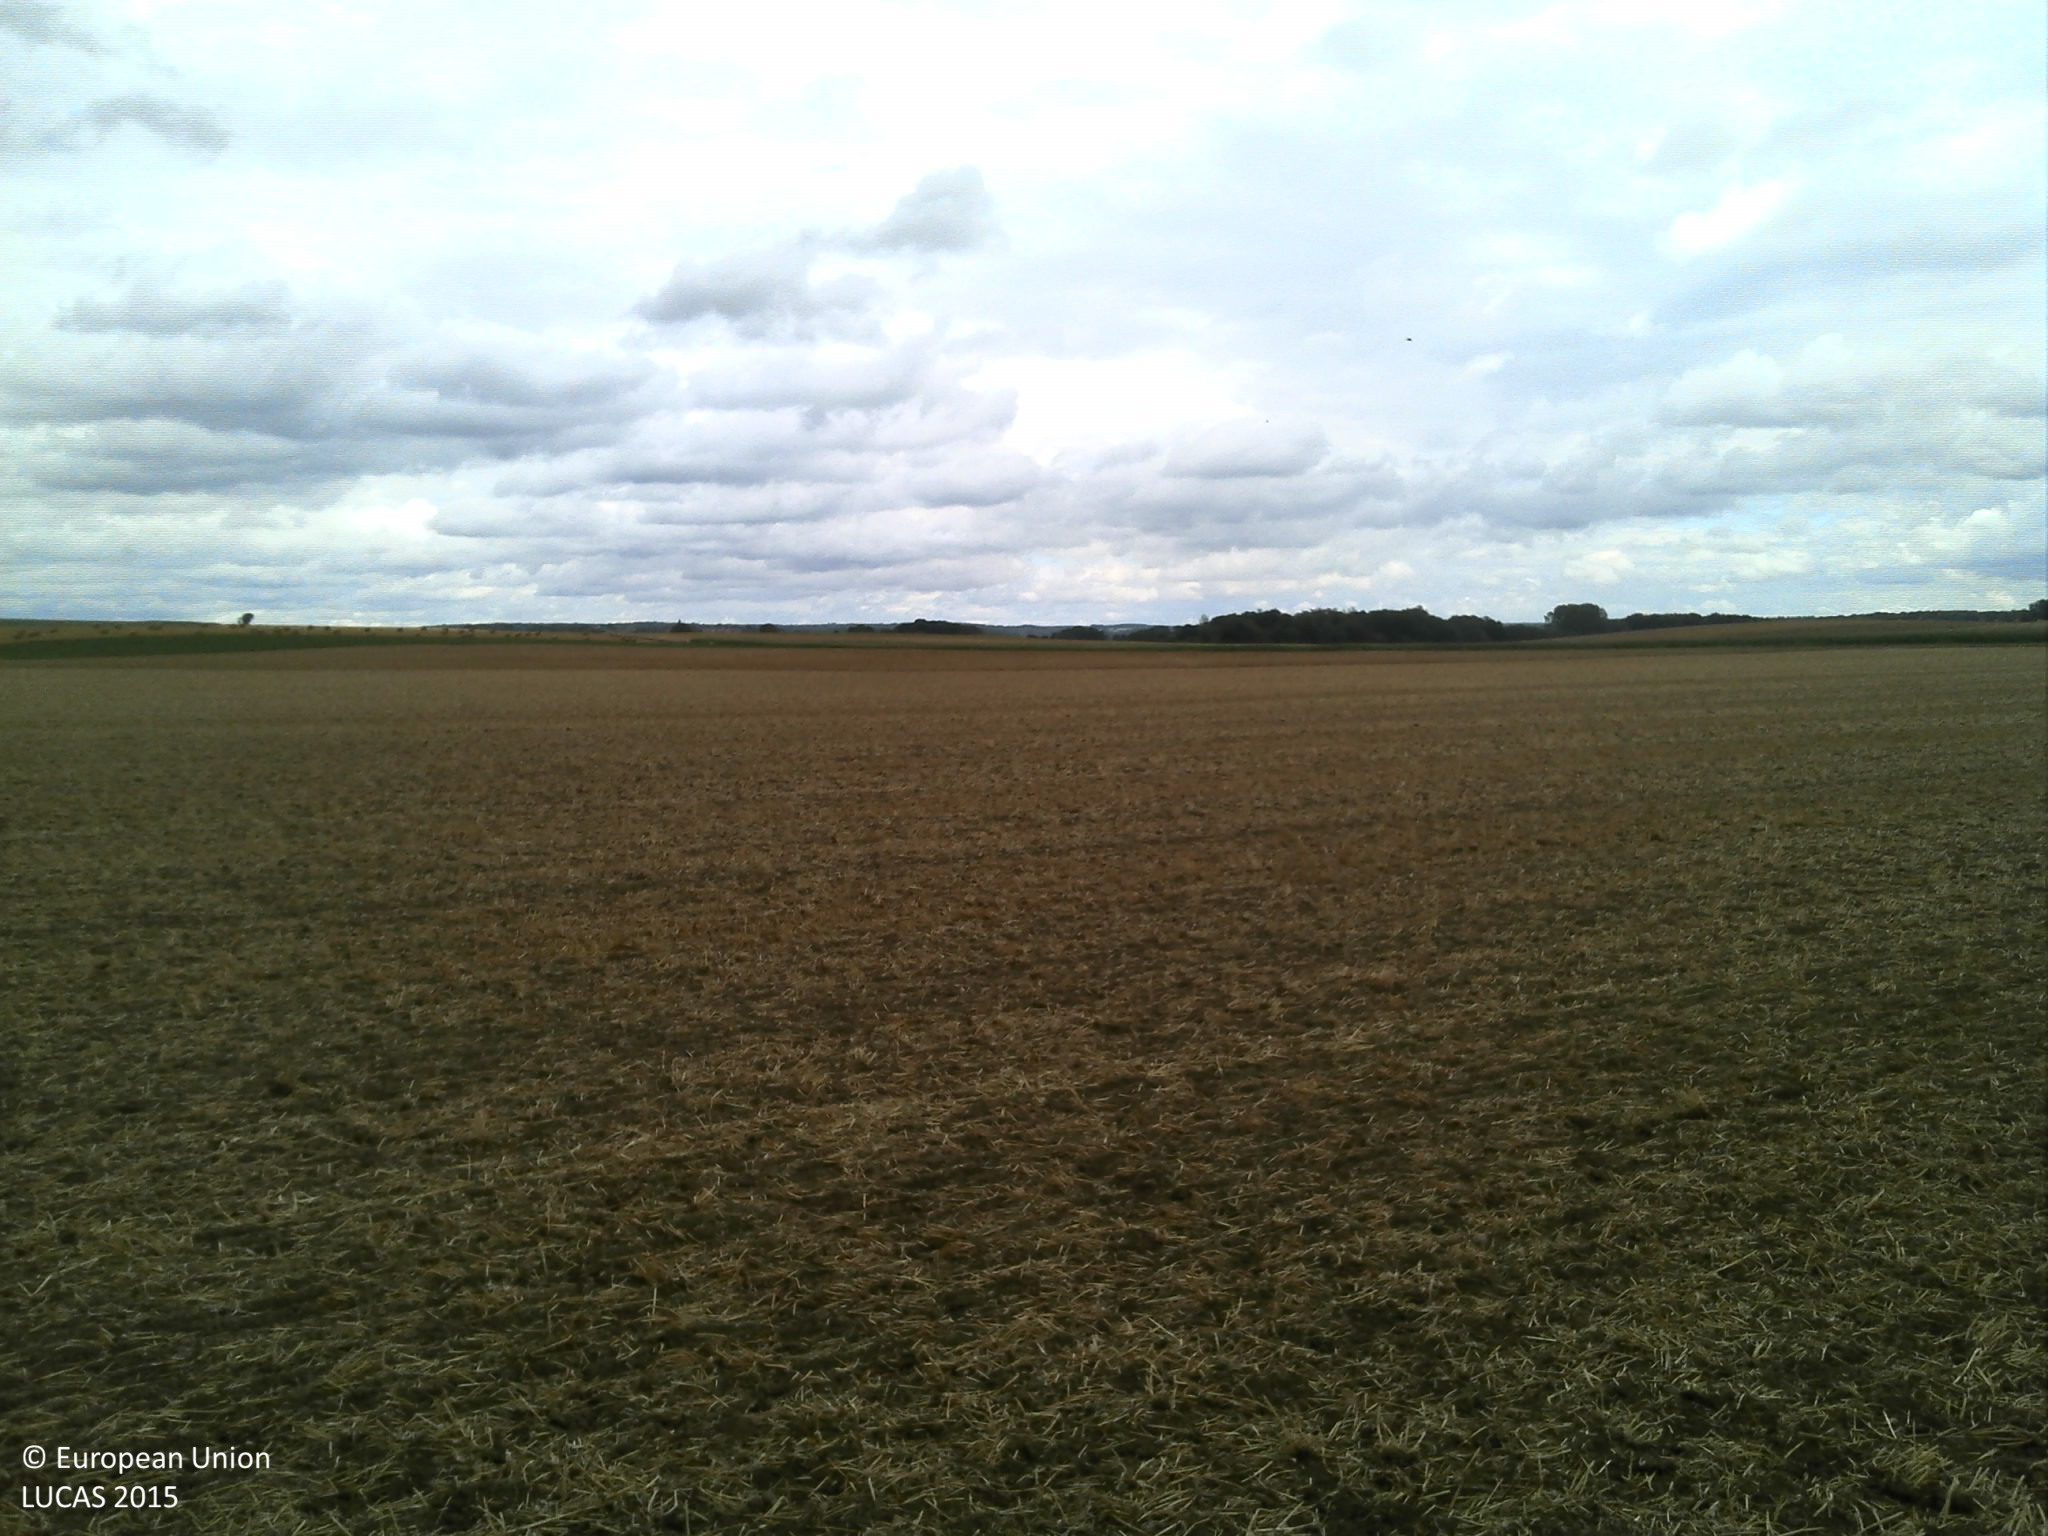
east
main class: Cropland
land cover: Barley
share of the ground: 25 - 50 %
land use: Agriculture (excluding fallow land and kitchen gardens)
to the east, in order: Barley; Rape and turnip rape
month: July
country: FR
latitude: 49.4616
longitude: 4.6019
